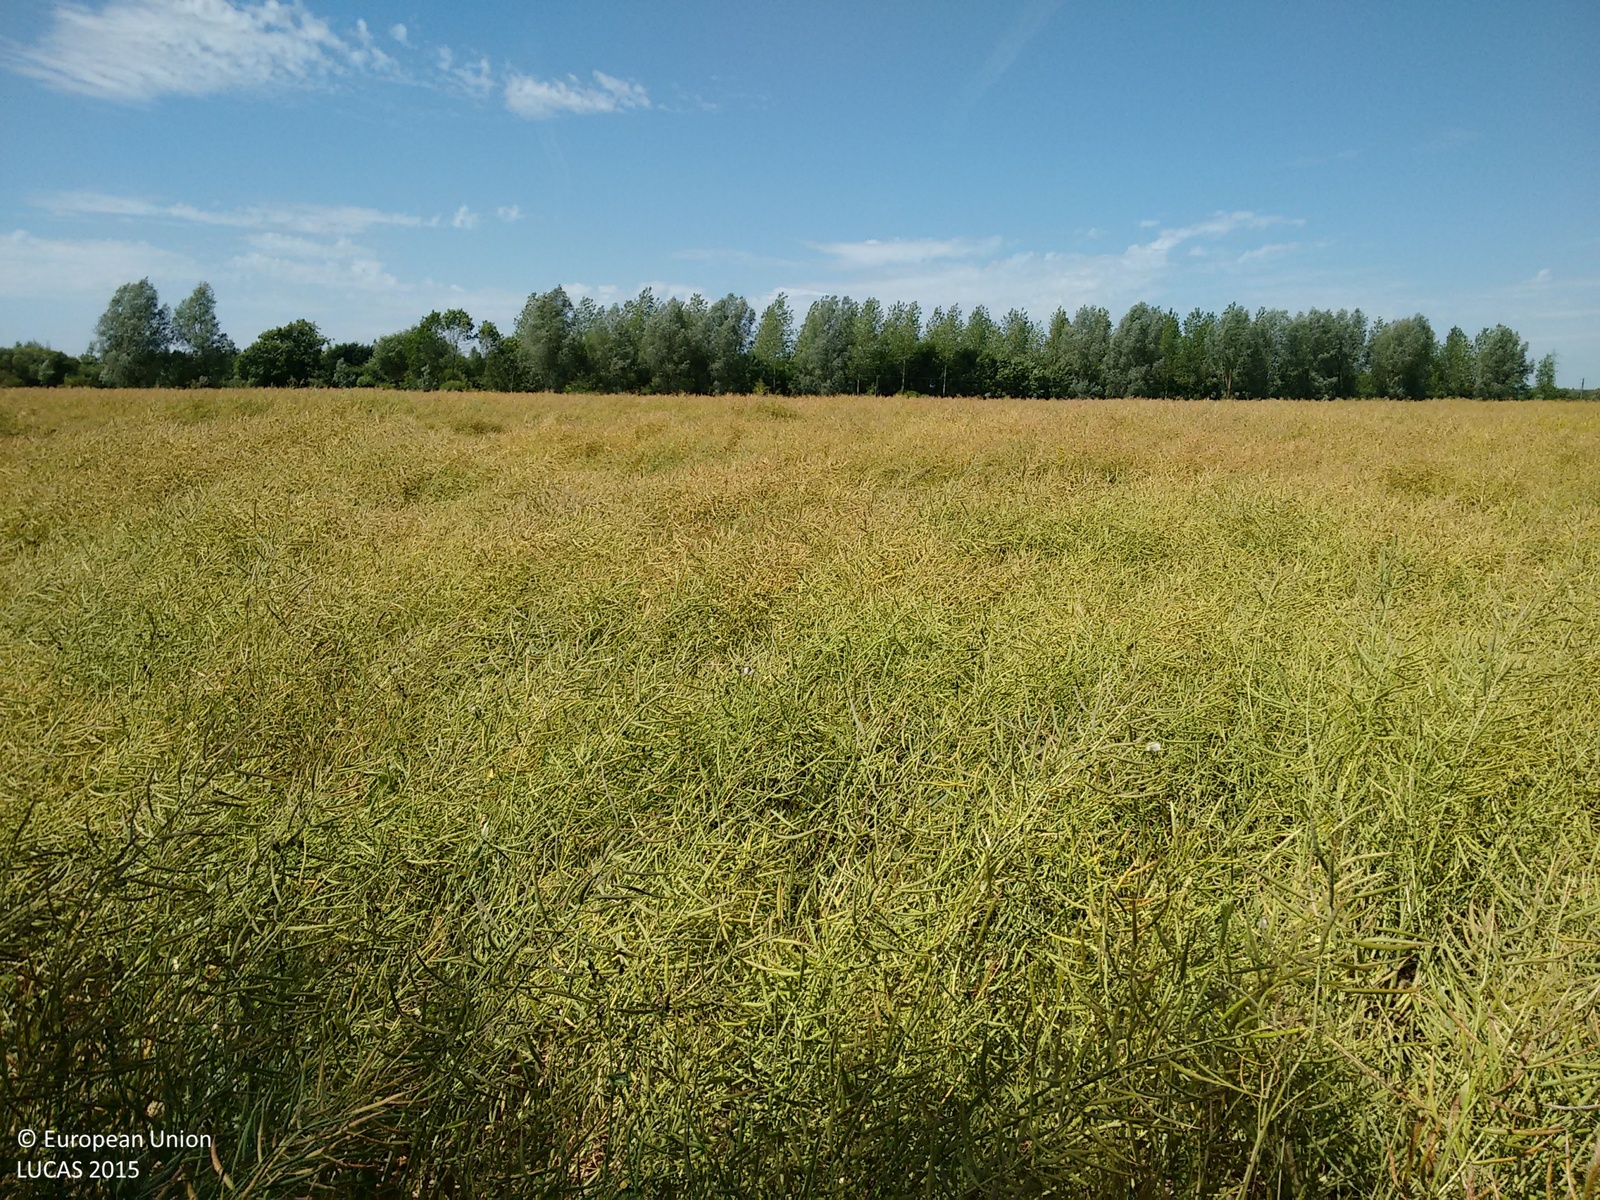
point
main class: Cropland
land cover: Rape and turnip rape
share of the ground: > 75 %
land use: Agriculture (excluding fallow land and kitchen gardens)
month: July
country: GB
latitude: 51.6796
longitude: -1.2270
